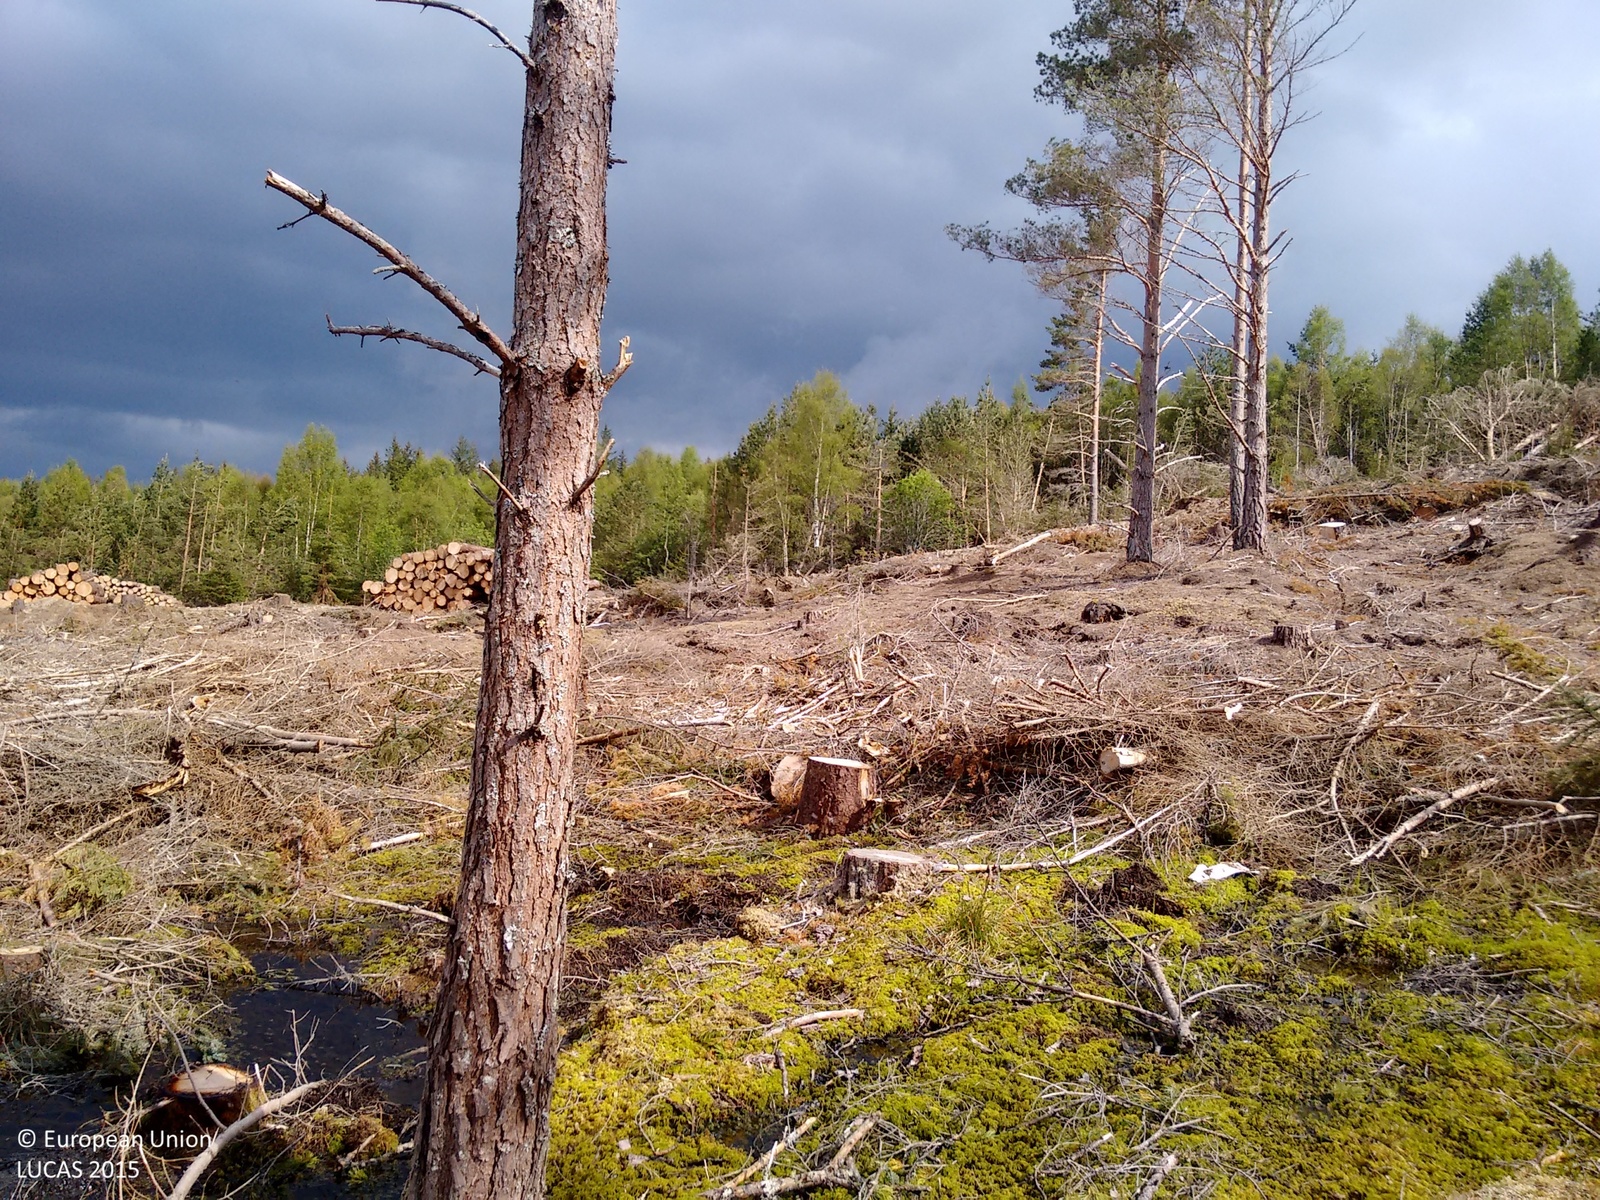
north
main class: Woodland
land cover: Pine dominated coniferous woodland
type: hemiboreal forest and nemoral coniferous forest and mixed broadleaved-coniferous forest
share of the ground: 25 - 50 %
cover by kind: lichens and mosses 50 %, coniferous forest trees 30 %
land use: Forestry
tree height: > 5 m
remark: Clear cut
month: June
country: GB
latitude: 57.1675
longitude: -3.6856
